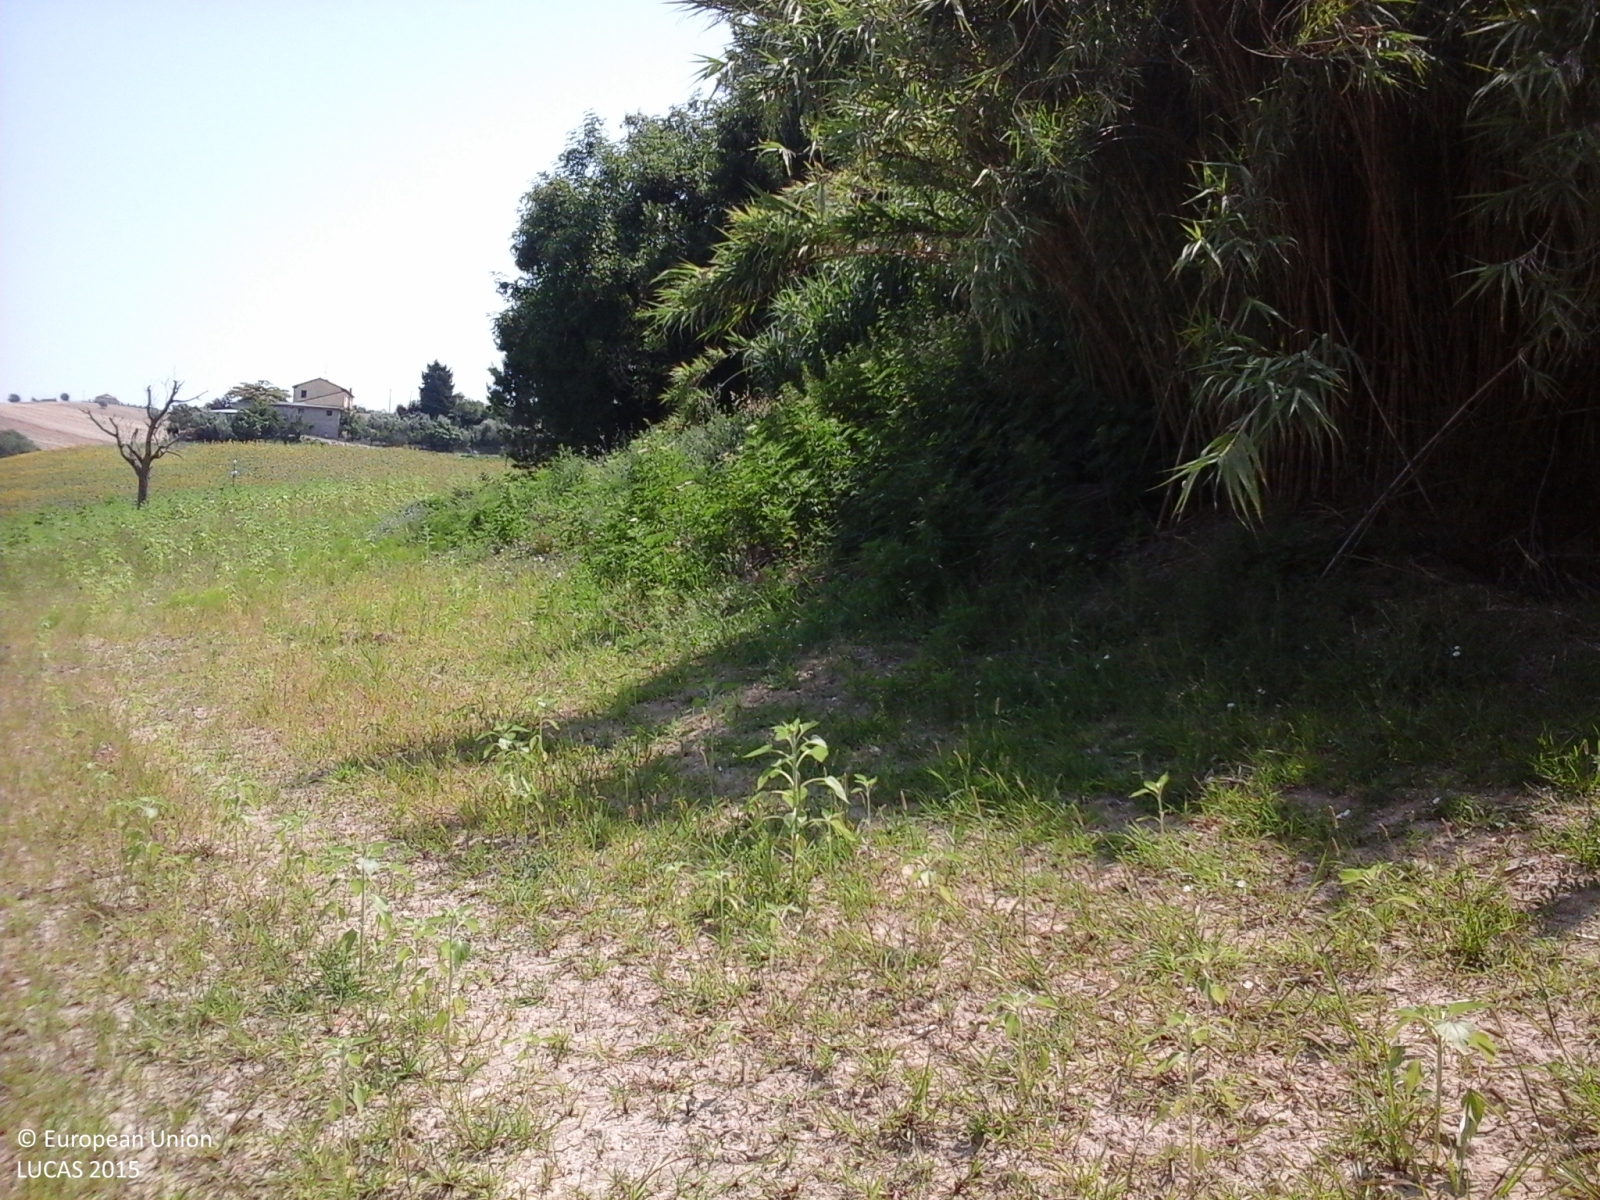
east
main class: Cropland
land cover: Sunflower
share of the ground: 25 - 50 %
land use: Agriculture (excluding fallow land and kitchen gardens)
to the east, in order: Sunflower; Shrubland with sparse tree cover; Artificial constructions in urban areas; Broadleaved woodland; Tracks; Electric lines; Tracks; Electric lines; Single bushes/trees; Grass margins; Durum wheat; Single bushes/trees; Sunflower
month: July
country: IT
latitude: 43.3900
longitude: 13.4603
